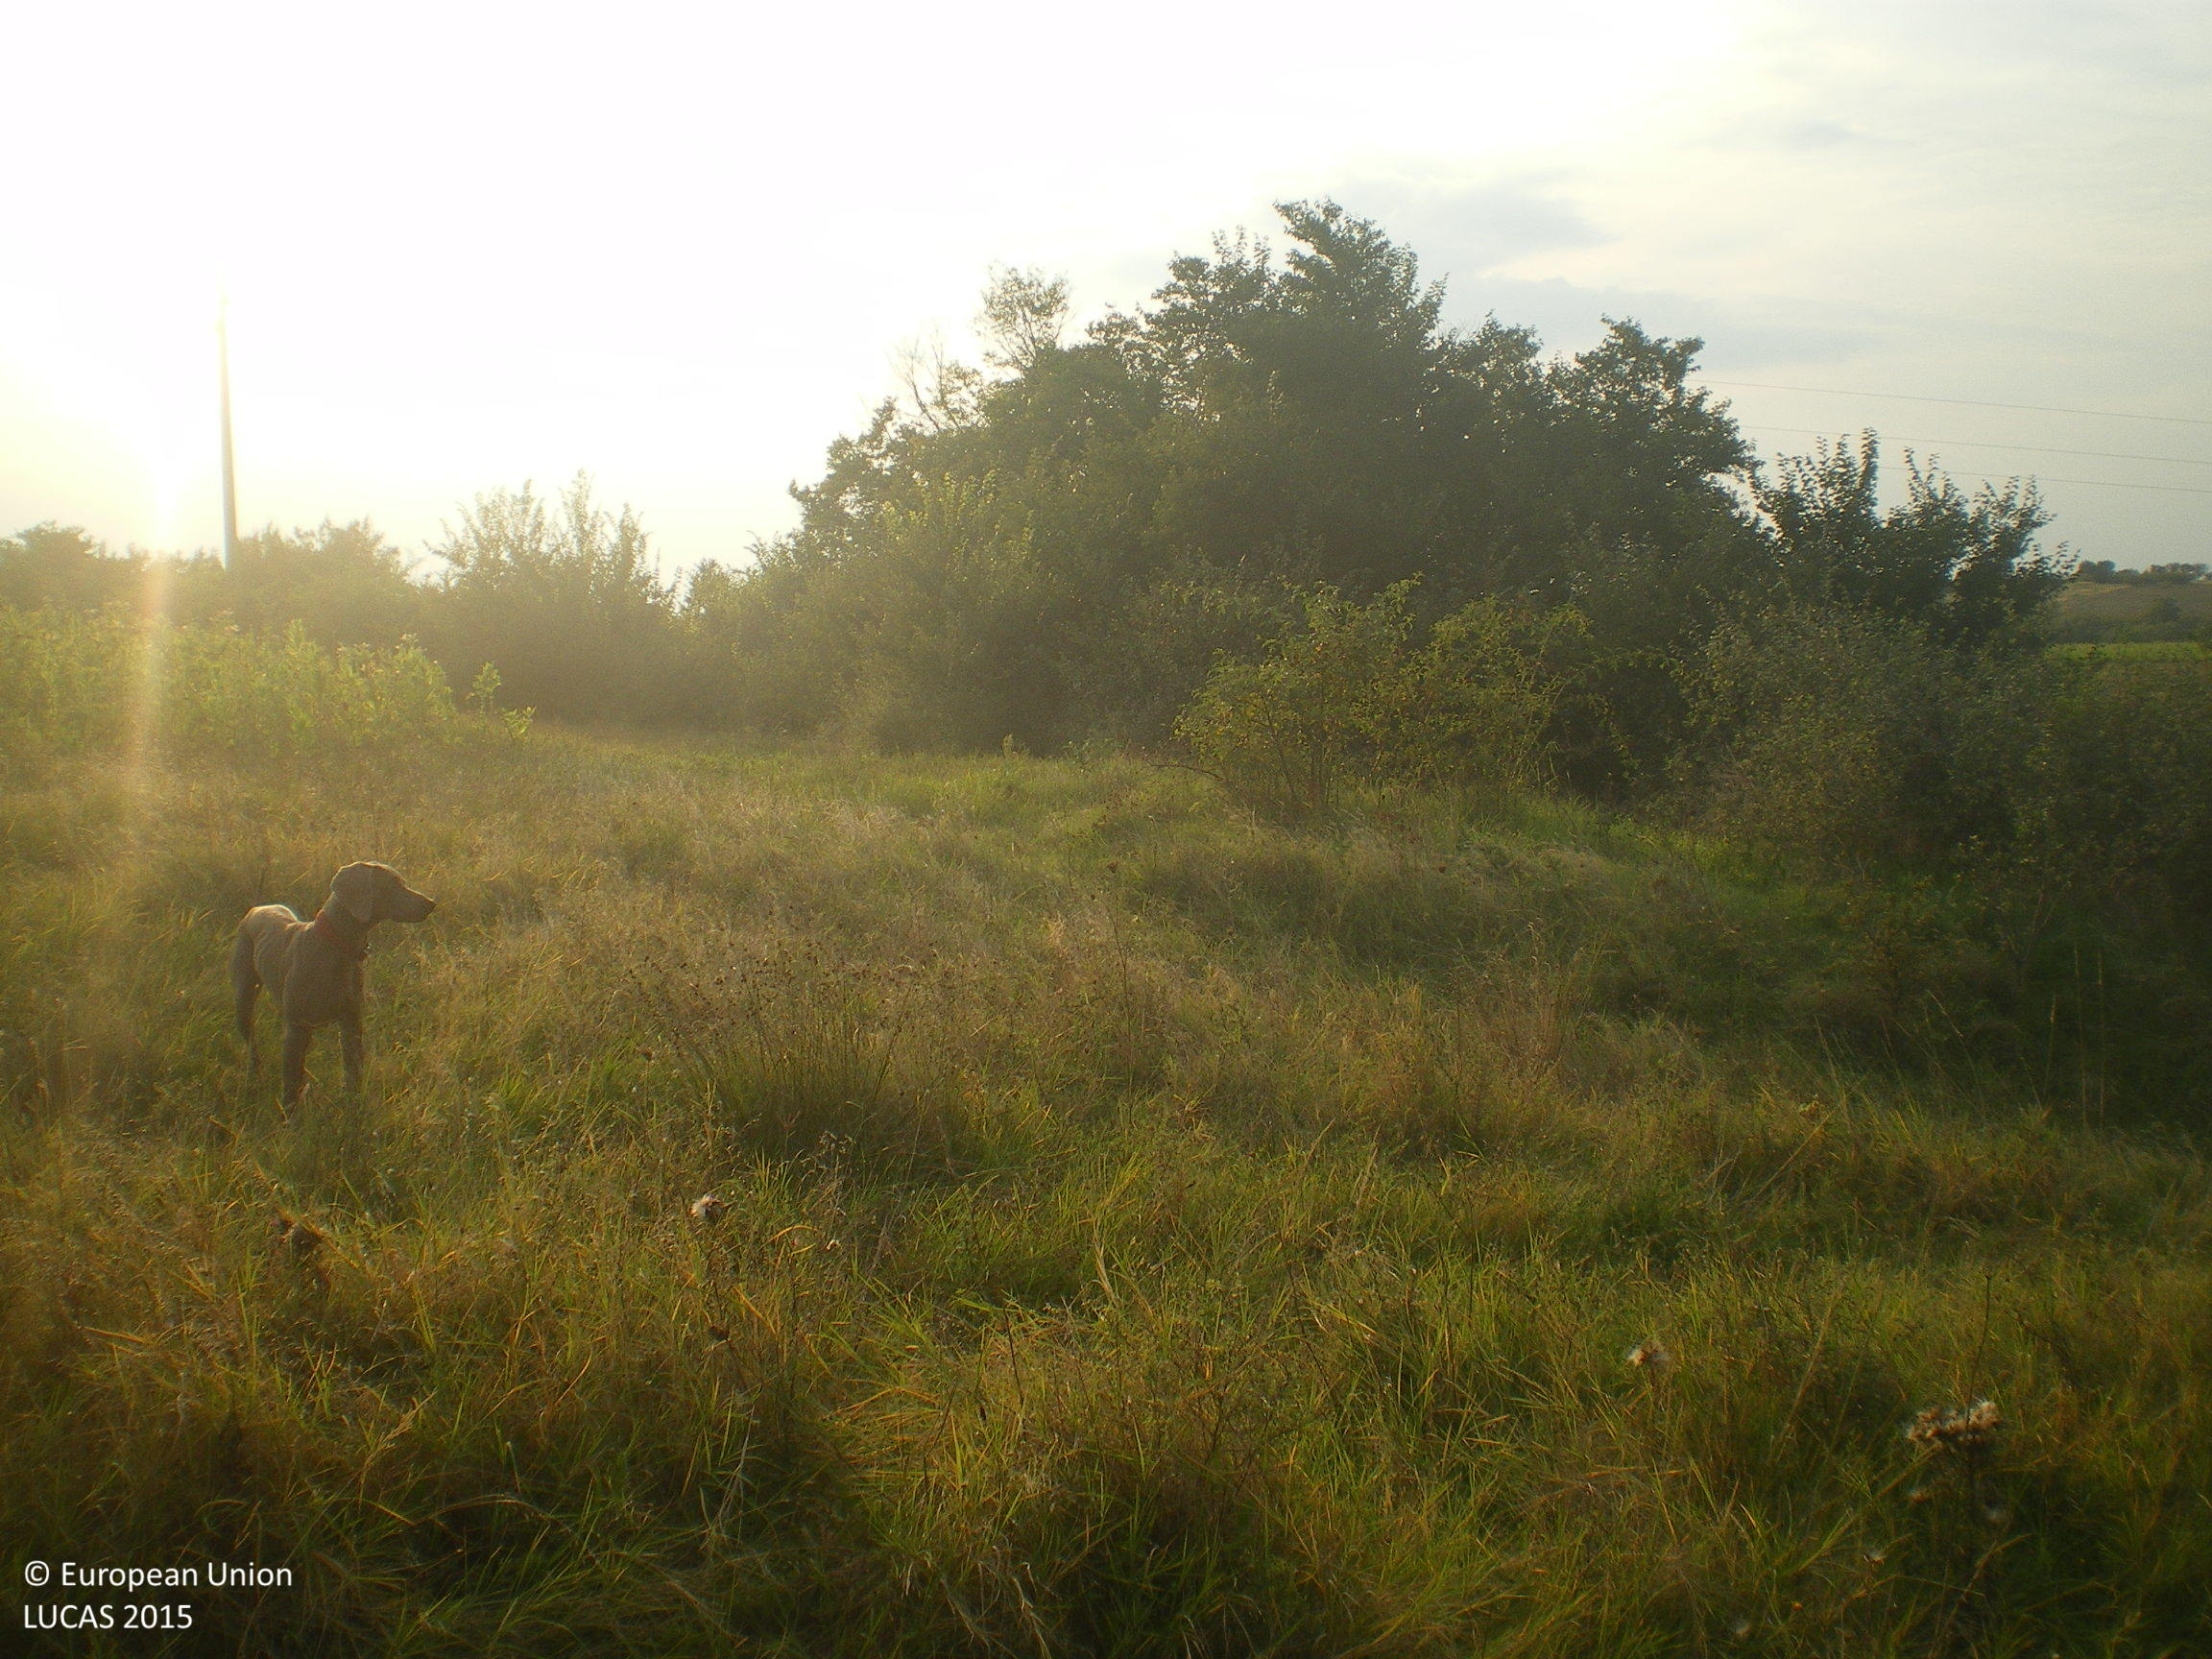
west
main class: Shrubland
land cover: Shrubland without tree cover
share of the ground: > 75 %
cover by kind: shrubs 70 %, herbaceous plants 30 %
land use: Semi-natural and natural areas not in use
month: October
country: BG
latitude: 41.8733
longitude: 26.3095
